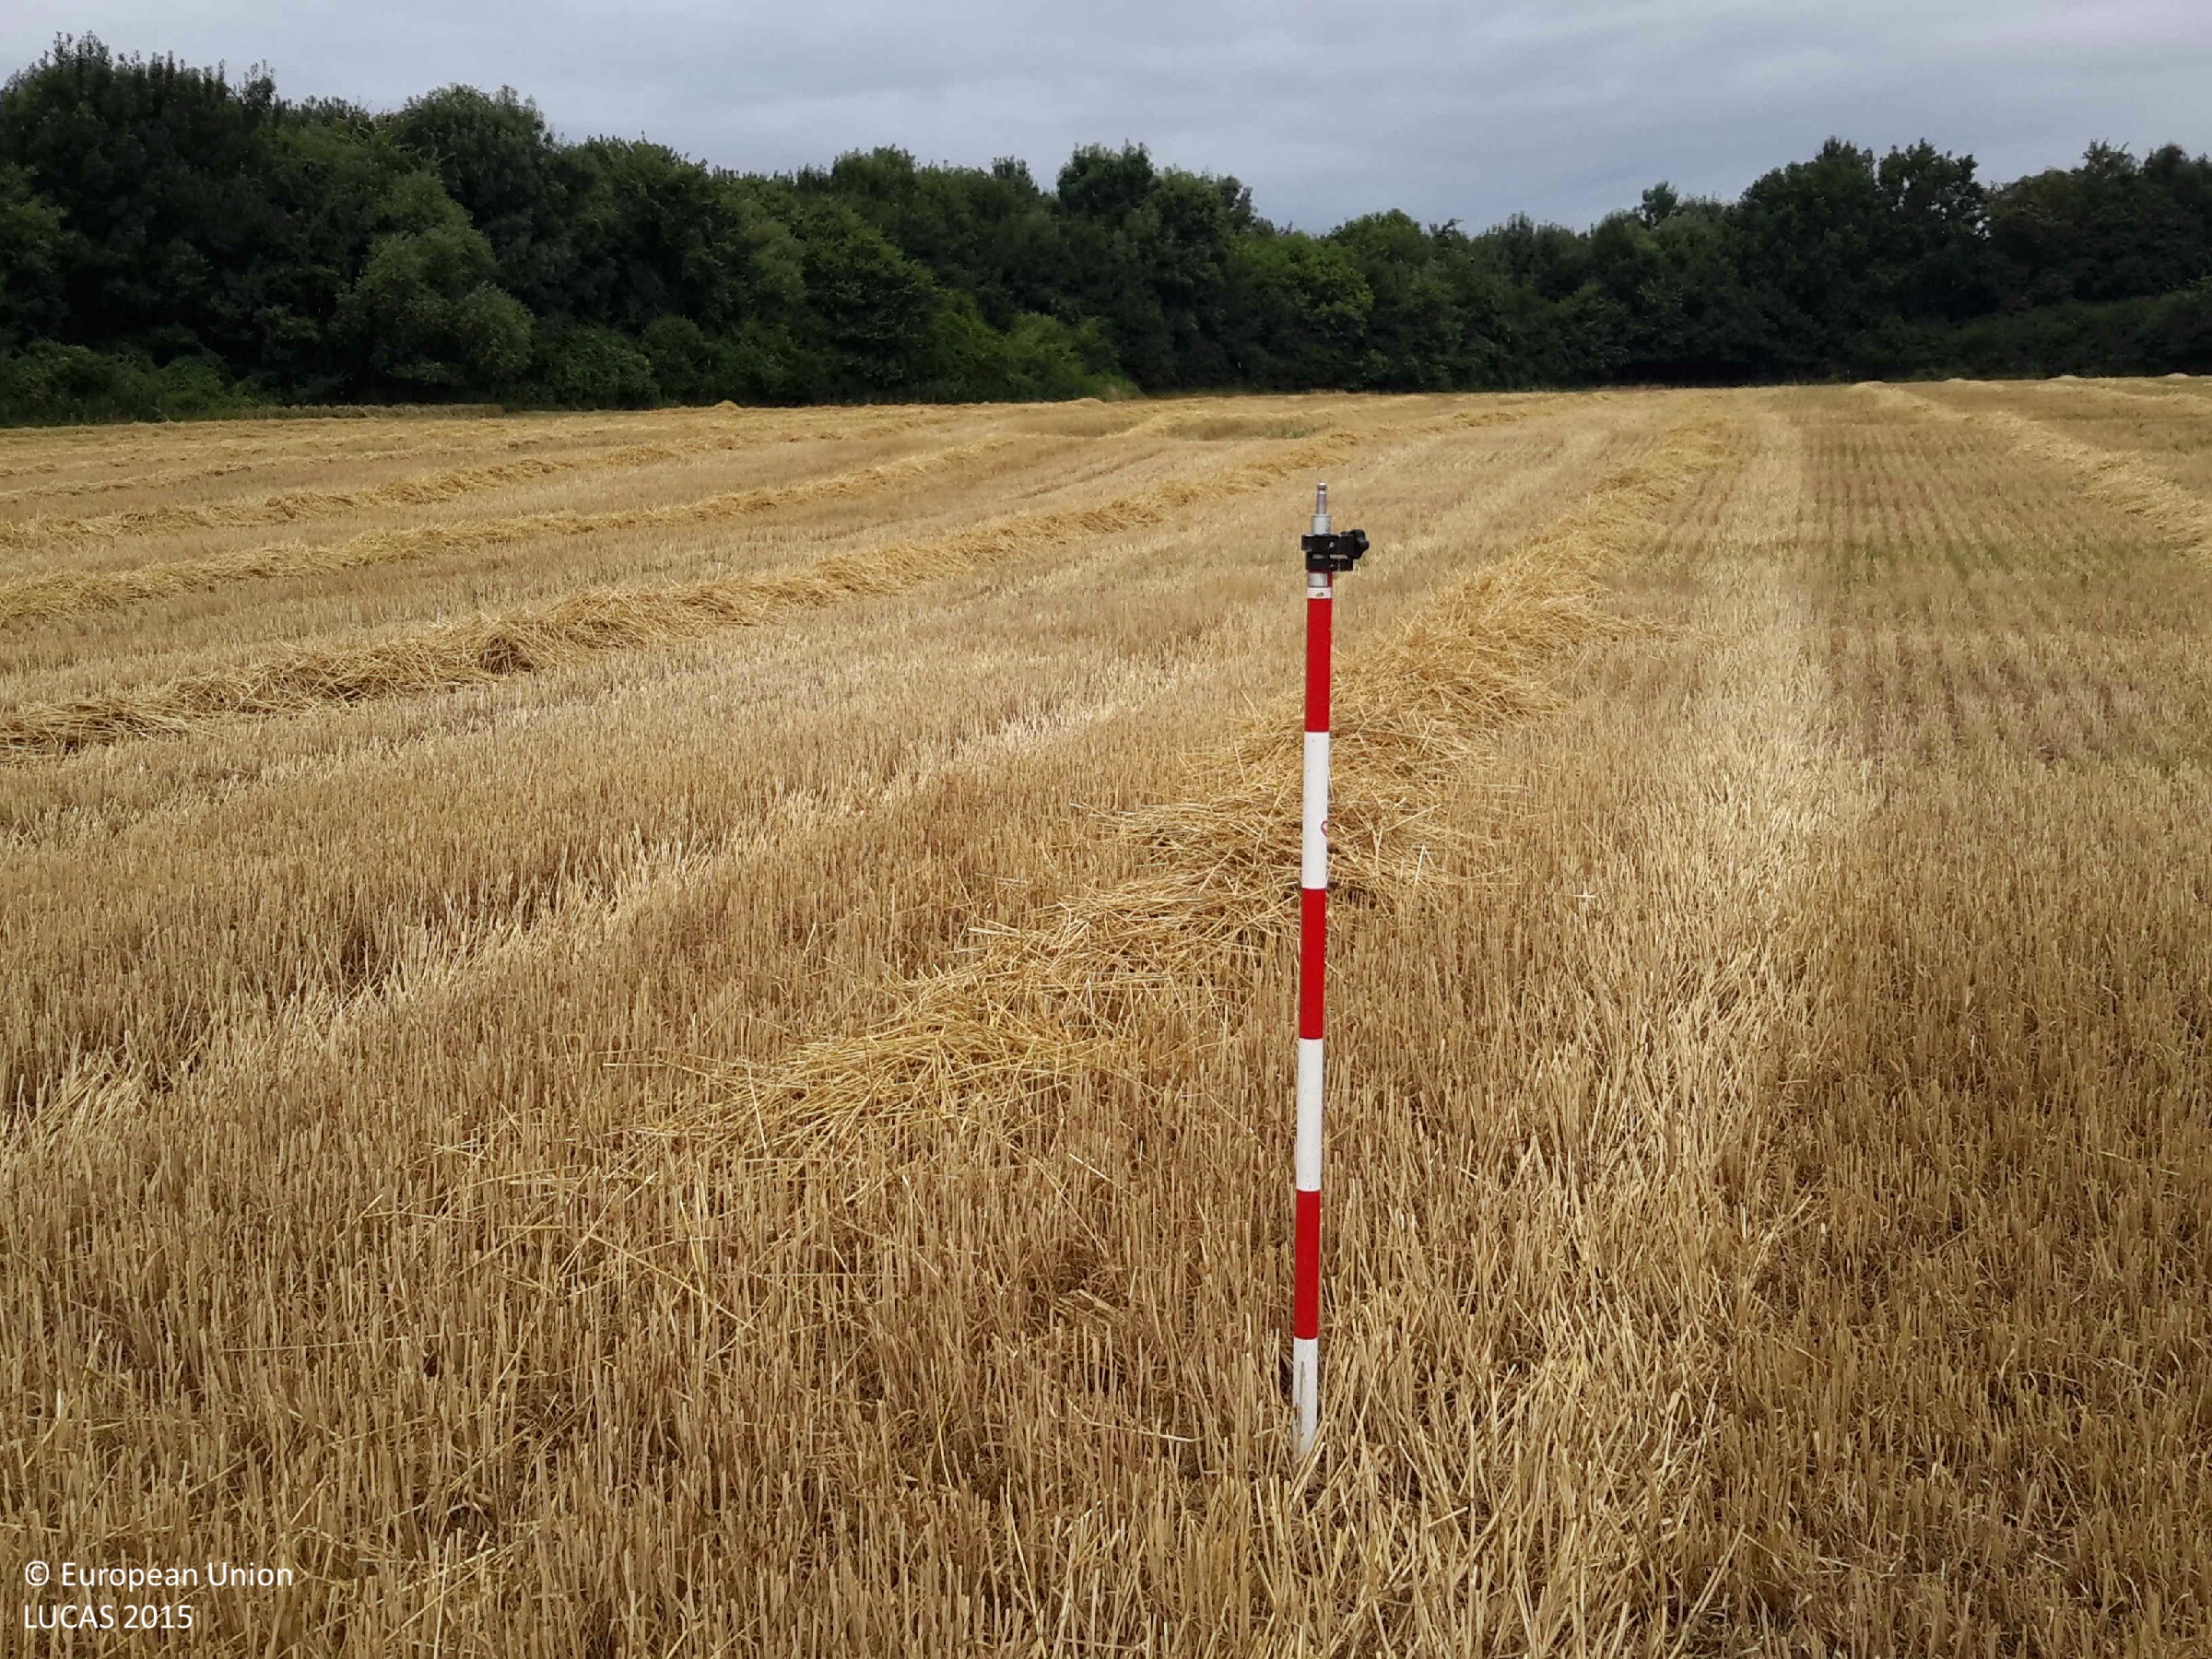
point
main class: Cropland
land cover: Common wheat
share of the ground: 50 - 75 %
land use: Agriculture (excluding fallow land and kitchen gardens)
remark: Harvested field
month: July
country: HU
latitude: 47.3825
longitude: 17.0657
